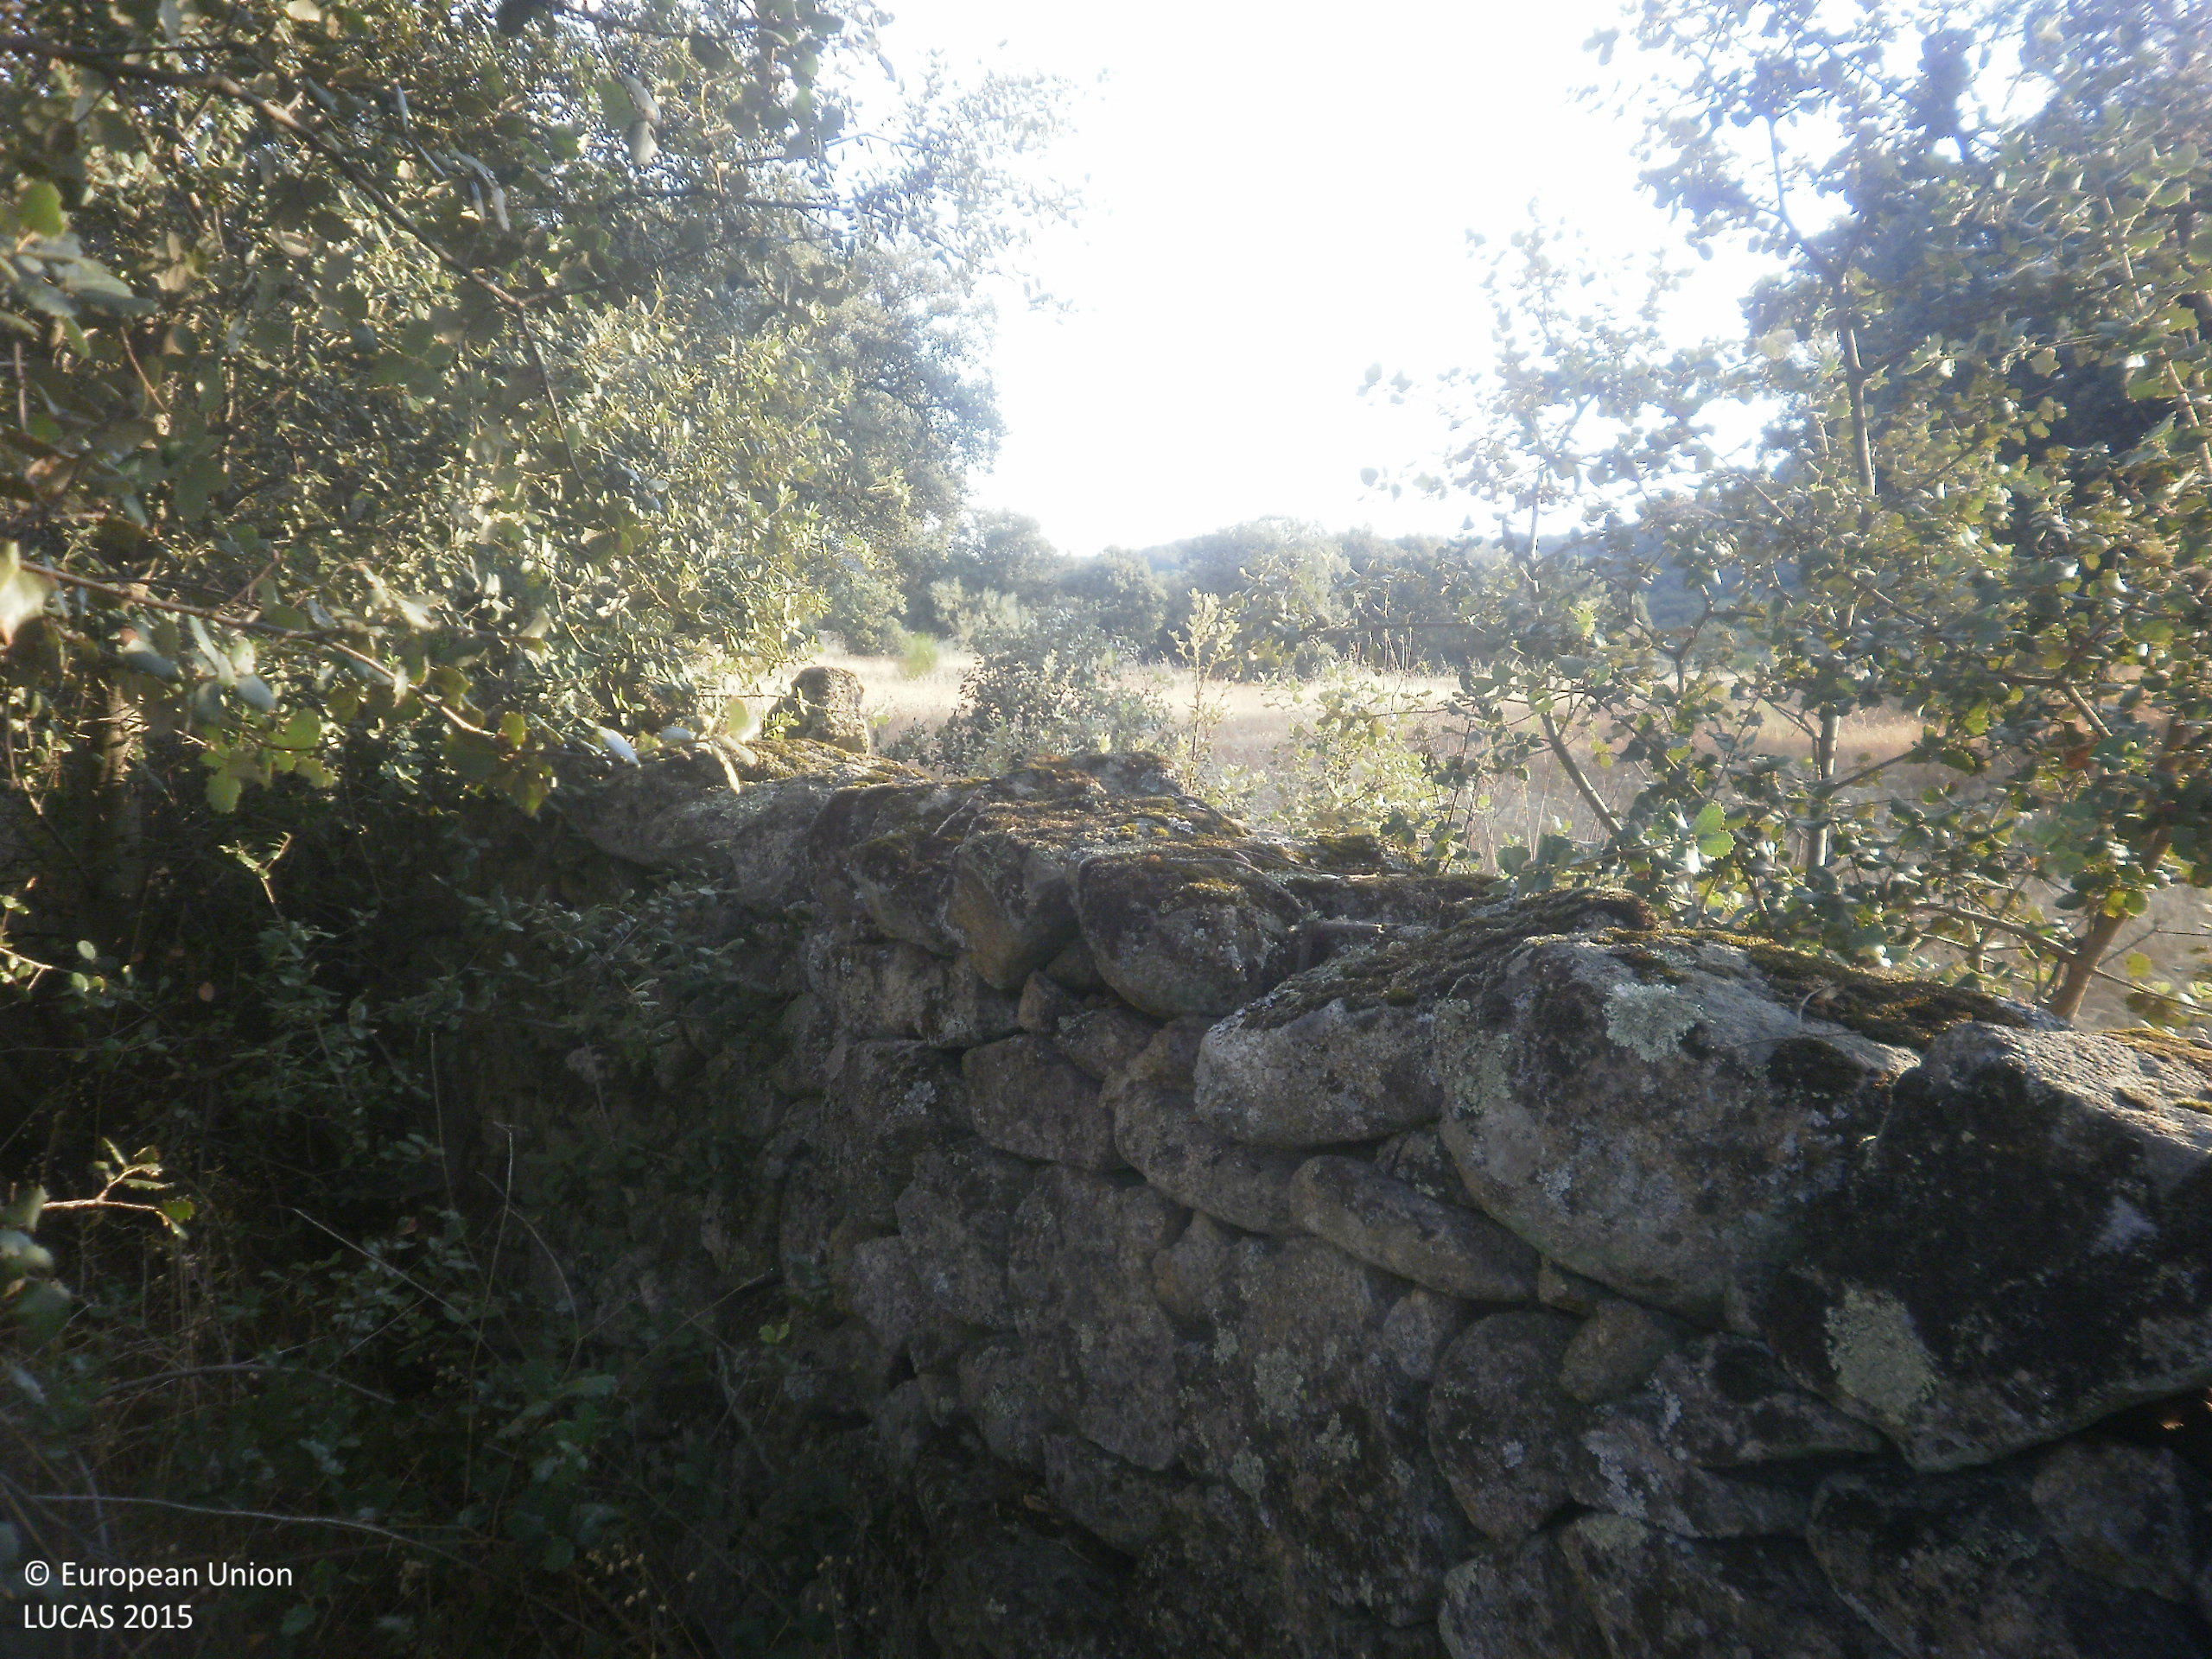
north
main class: Woodland
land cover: Broadleaved woodland
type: broadleaved evergreen forest
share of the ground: 50 - 75 %
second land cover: Grassland without tree/shrub cover
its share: 50 - 75 %
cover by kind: herbaceous plants 70 %, broadleaved forest trees 20 %, shrubs 10 %
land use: Forestry
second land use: Agriculture (excluding fallow land and kitchen gardens)
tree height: > 5 m
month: June
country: ES
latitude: 39.2665
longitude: -5.9464
